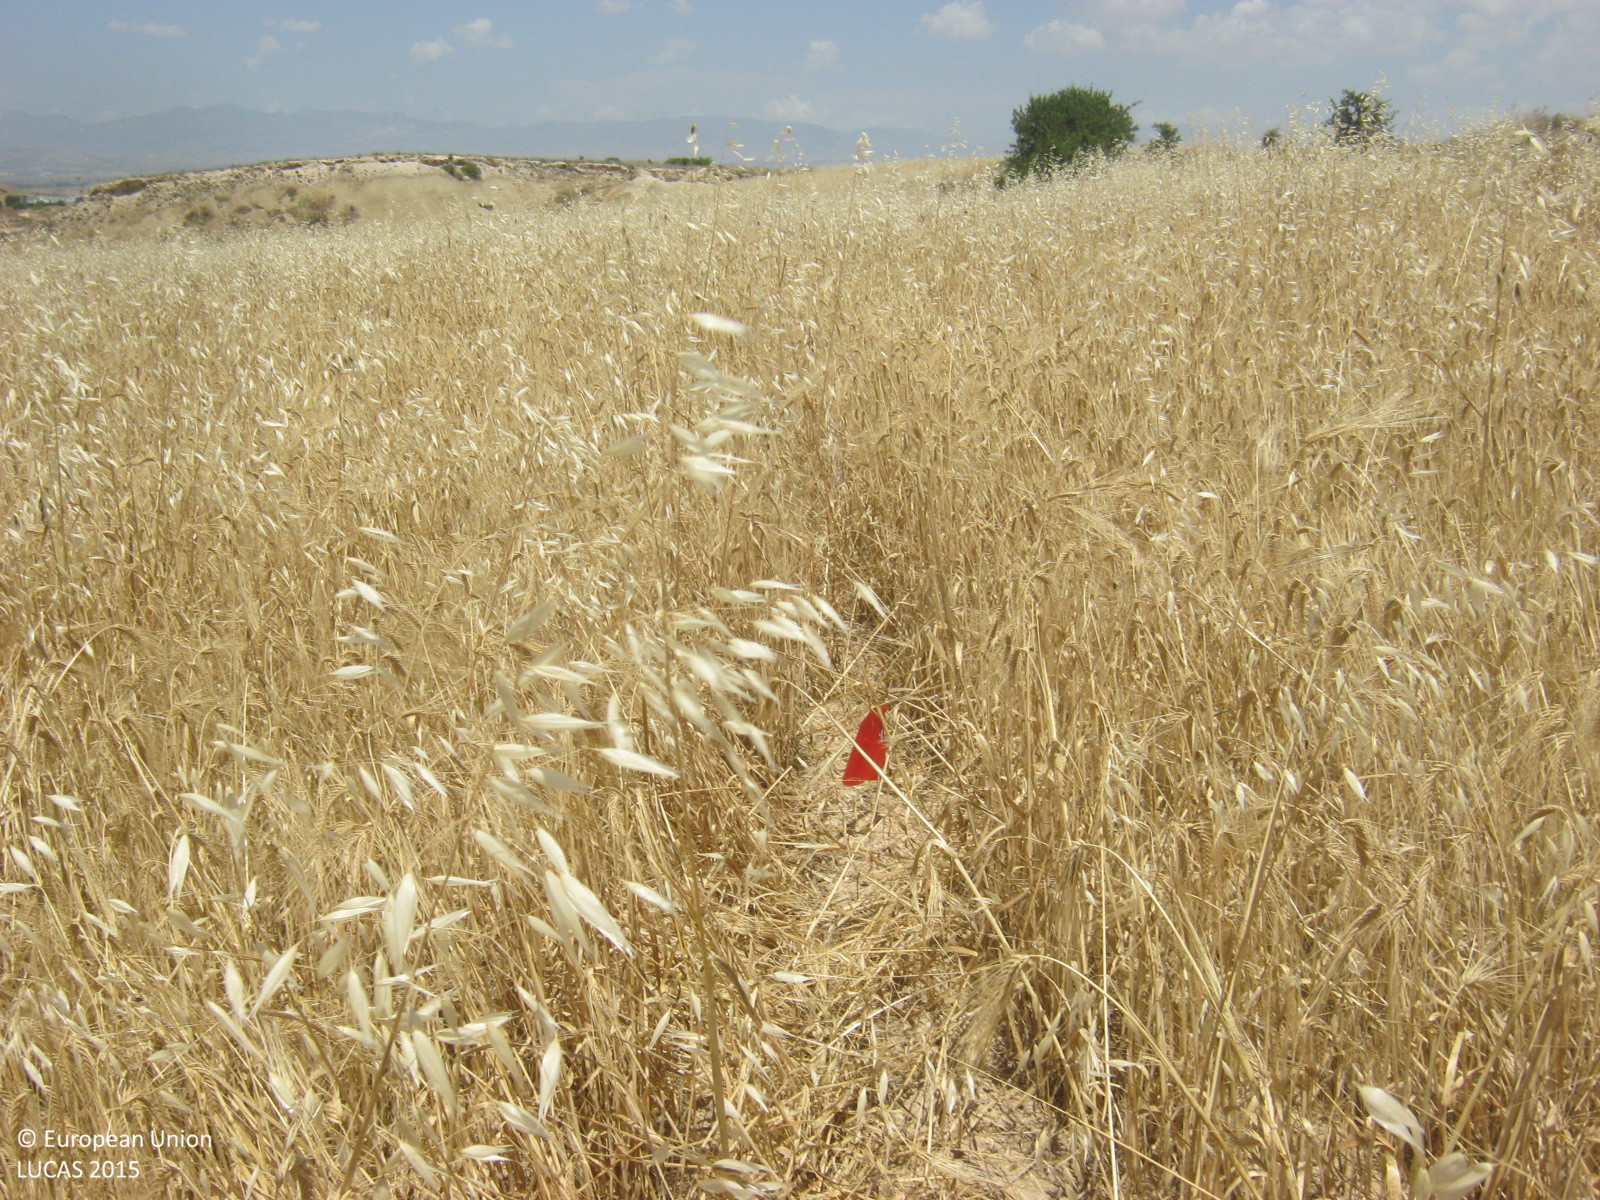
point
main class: Cropland
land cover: Mixed cereals for fodder
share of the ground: > 75 %
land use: Agriculture (excluding fallow land and kitchen gardens)
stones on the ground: < 10 %
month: May
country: CY
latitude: 35.0660
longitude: 33.1094
